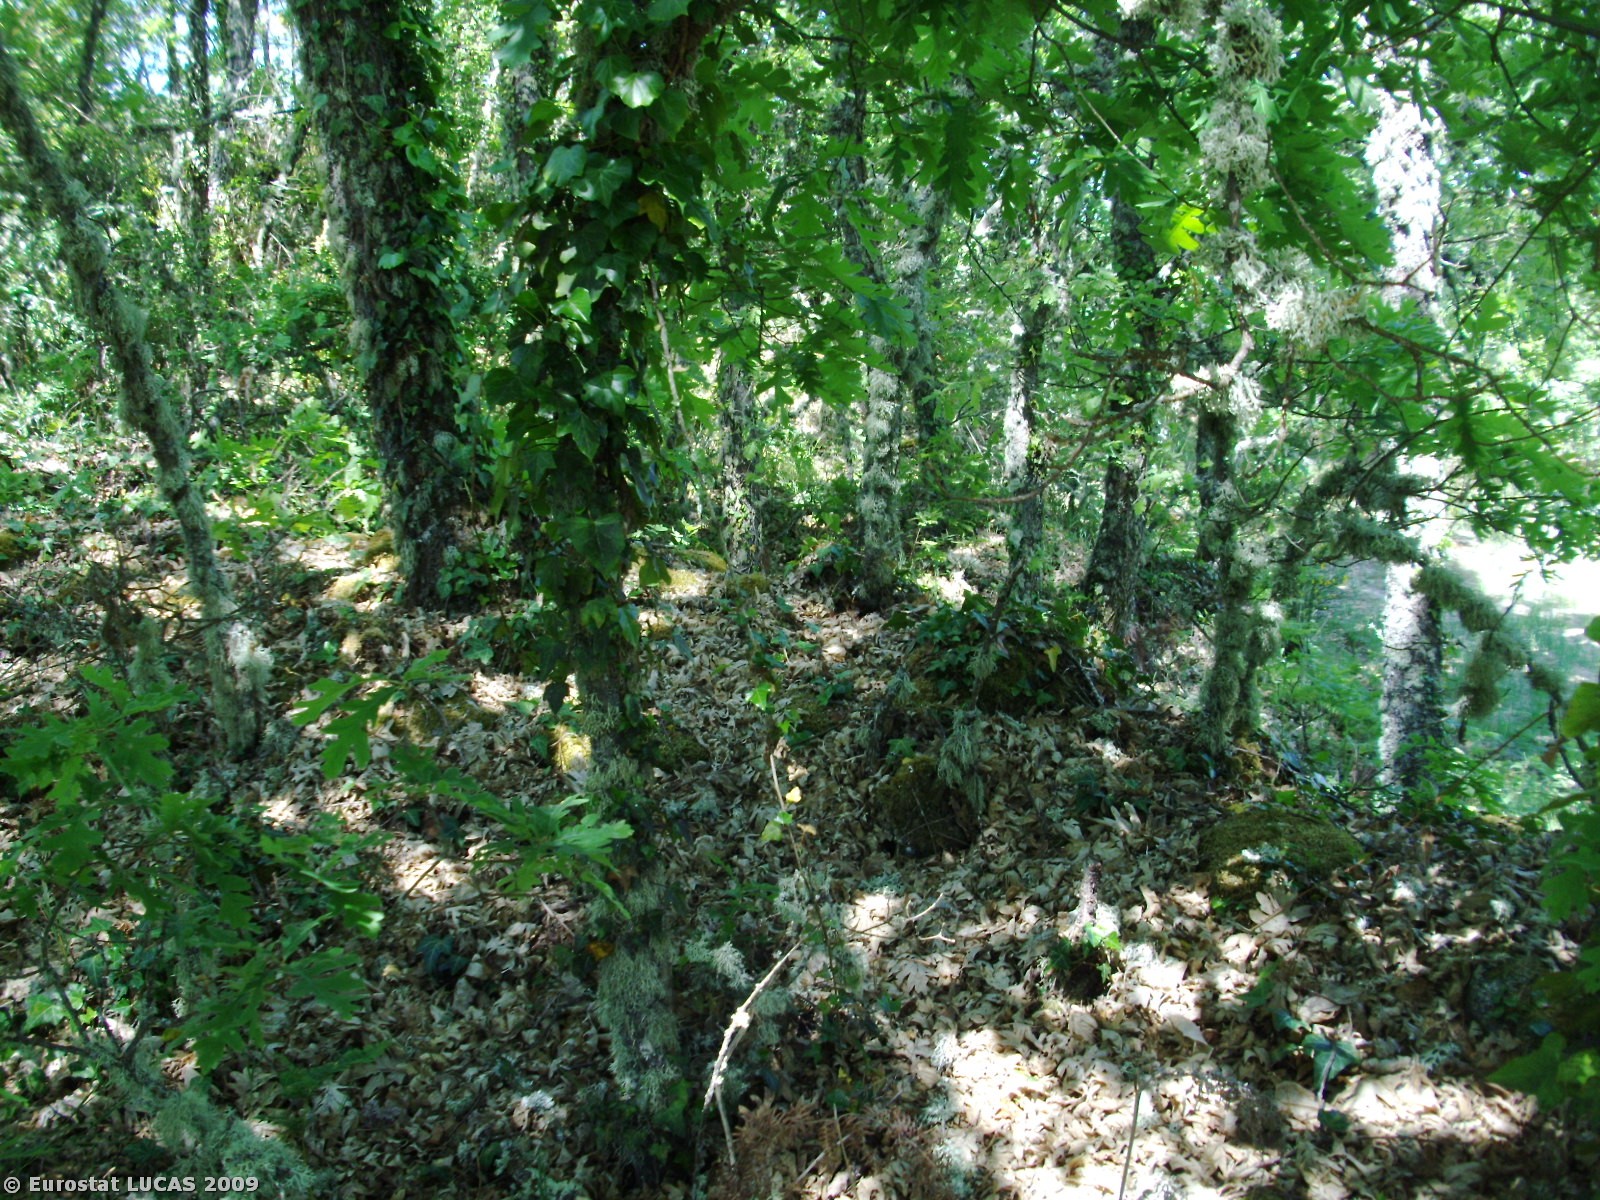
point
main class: Woodland
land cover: Broadleaved woodland
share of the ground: > 75 %
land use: Forestry
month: May
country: PT
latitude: 40.7825
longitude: -7.3046
